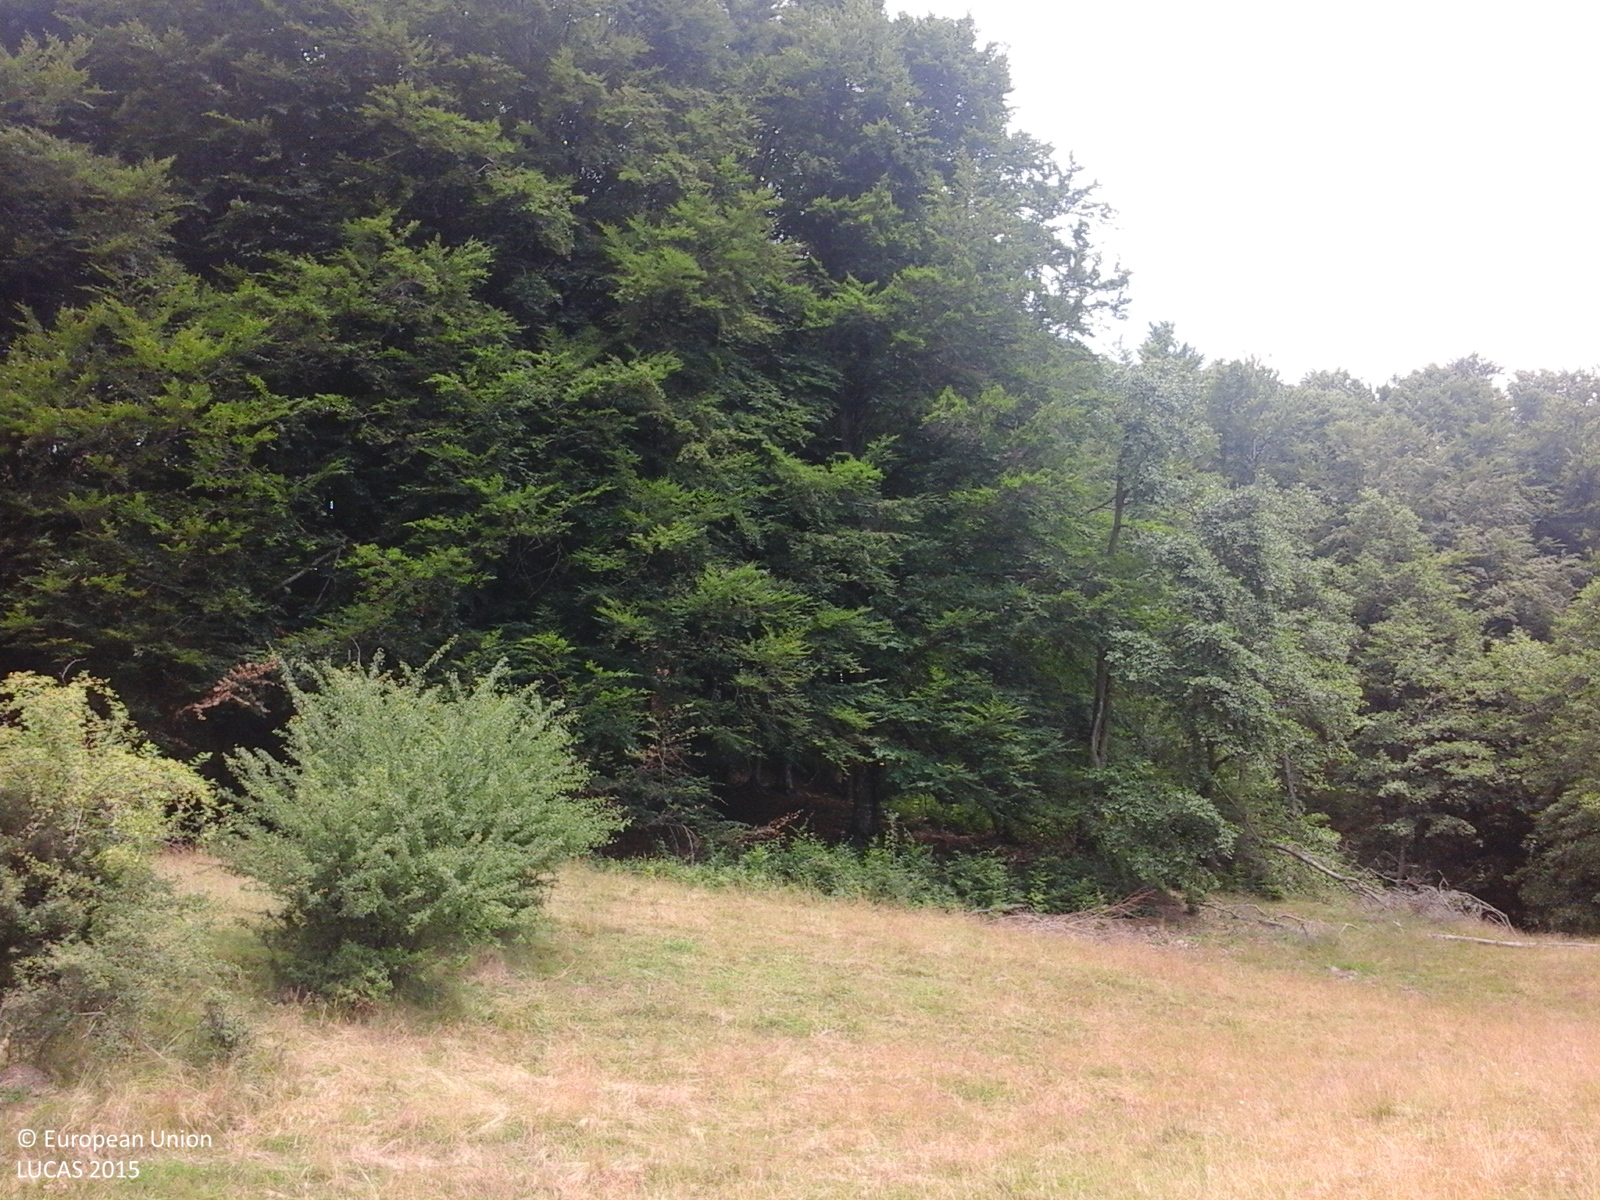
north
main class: Grassland
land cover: Grassland with sparse tree/shrub cover
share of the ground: > 75 %
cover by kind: herbaceous plants 85 %, unconsolidated bare surface 10 %, broadleaved forest trees 5 %
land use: Agriculture (excluding fallow land and kitchen gardens)
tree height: < 5 m
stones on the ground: 10 - 25 %
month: July
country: RO
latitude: 45.2839
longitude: 24.8872
